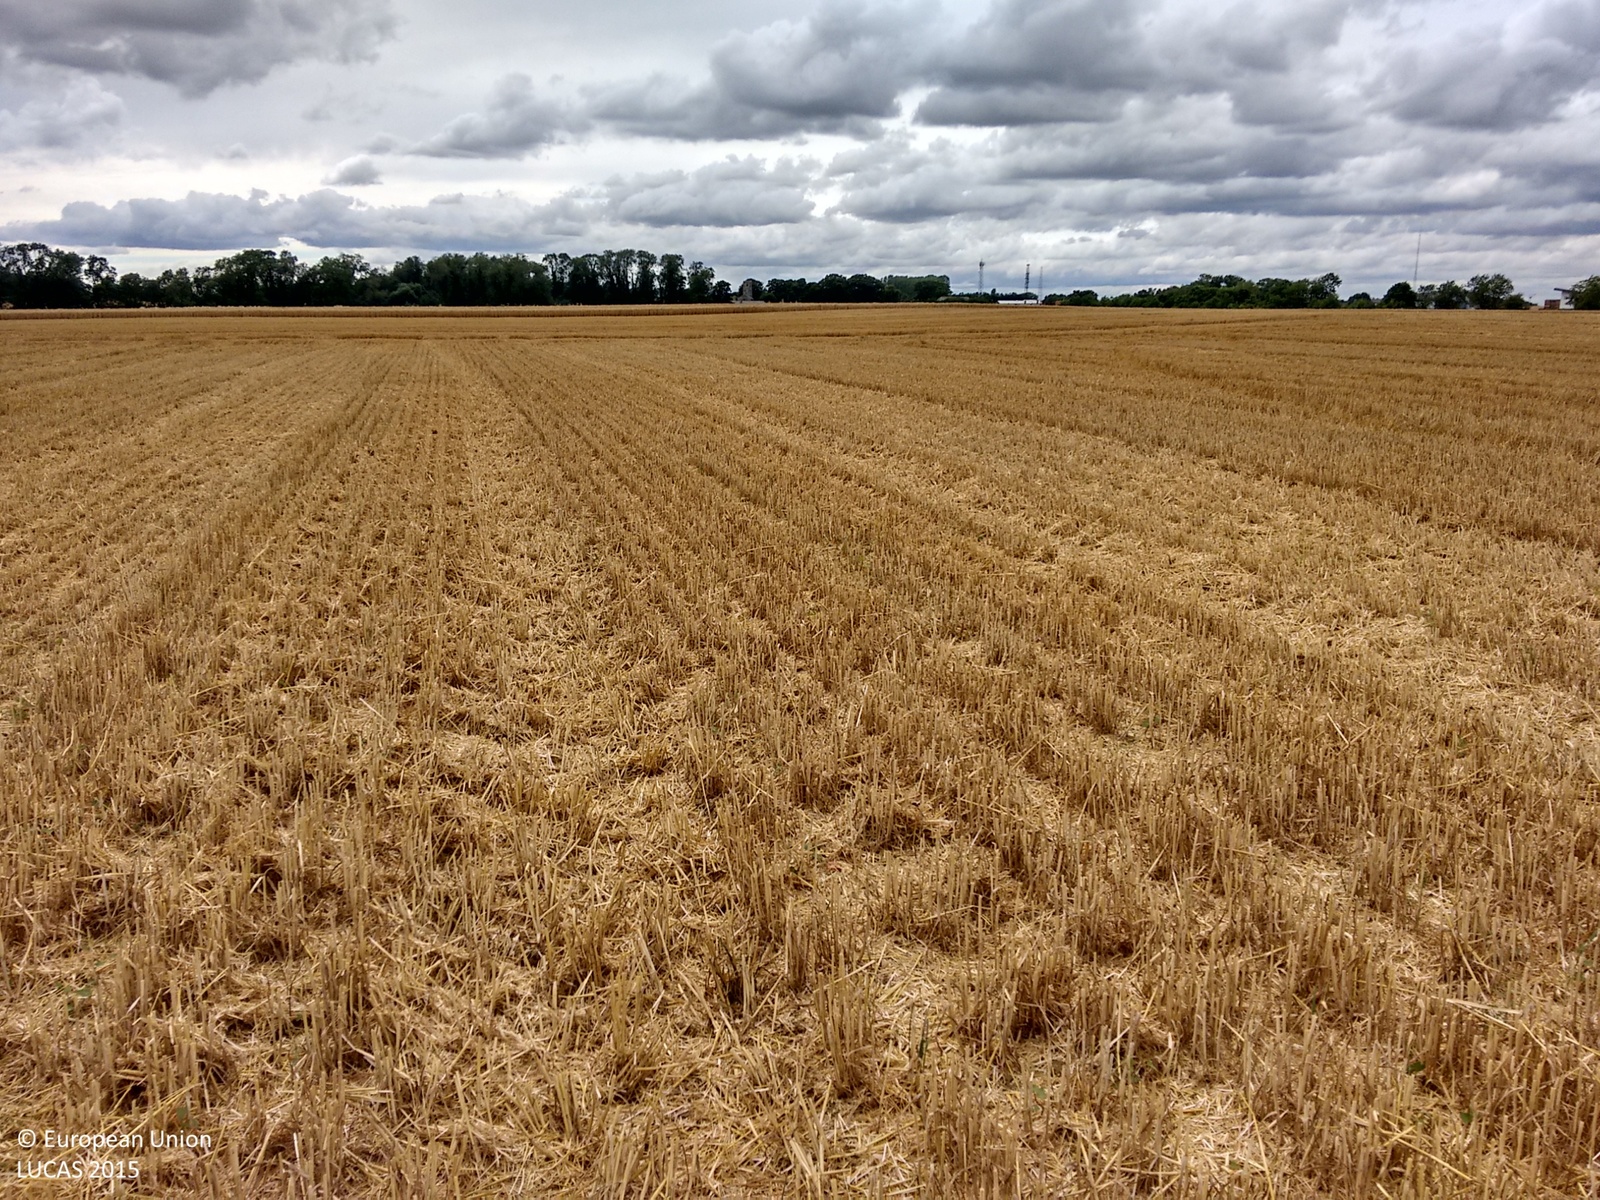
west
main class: Cropland
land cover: Common wheat
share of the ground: > 75 %
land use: Agriculture (excluding fallow land and kitchen gardens)
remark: Harvested field
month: August
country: GB
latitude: 52.6047
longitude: 0.4182
